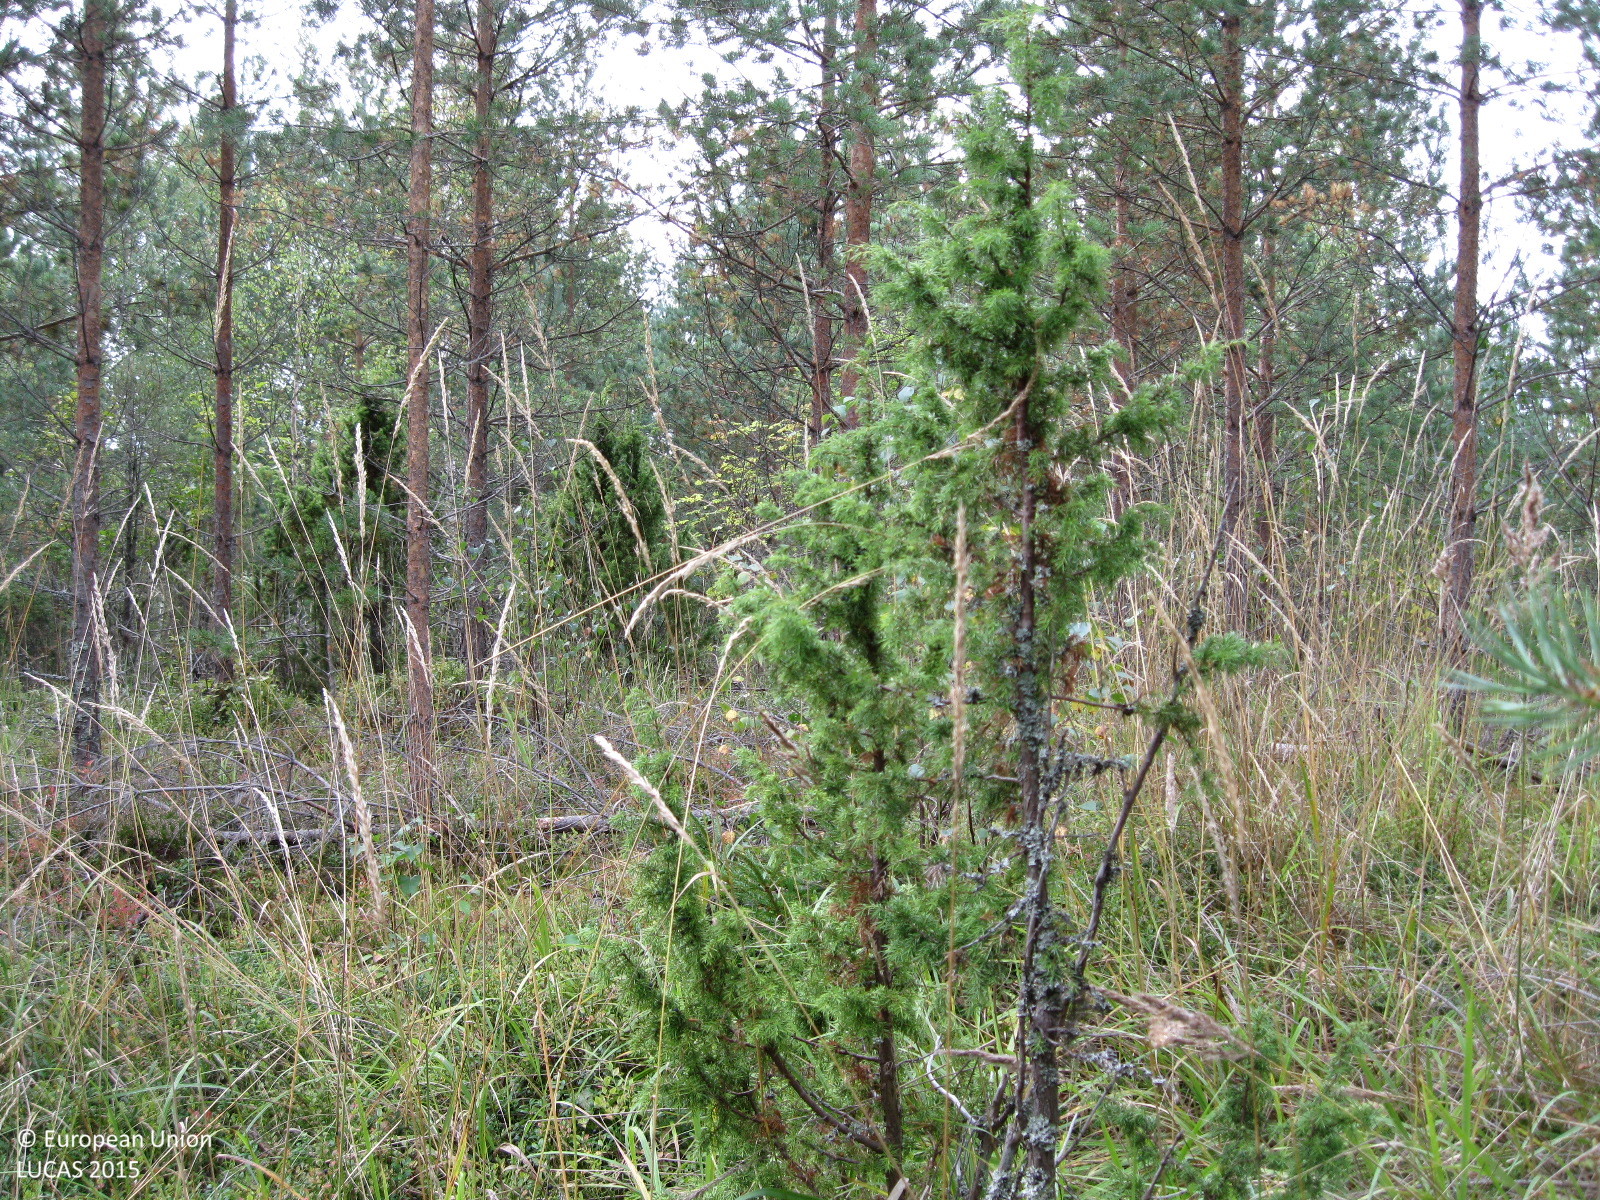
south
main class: Woodland
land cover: Pine dominated mixed woodland
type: boreal forest
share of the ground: 50 - 75 %
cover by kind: coniferous forest trees 50 %, broadleaved forest trees 20 %, herbaceous plants 20 %, shrubs 10 %
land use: Forestry
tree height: > 5 m
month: September
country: FI
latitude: 60.5140
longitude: 24.6250
